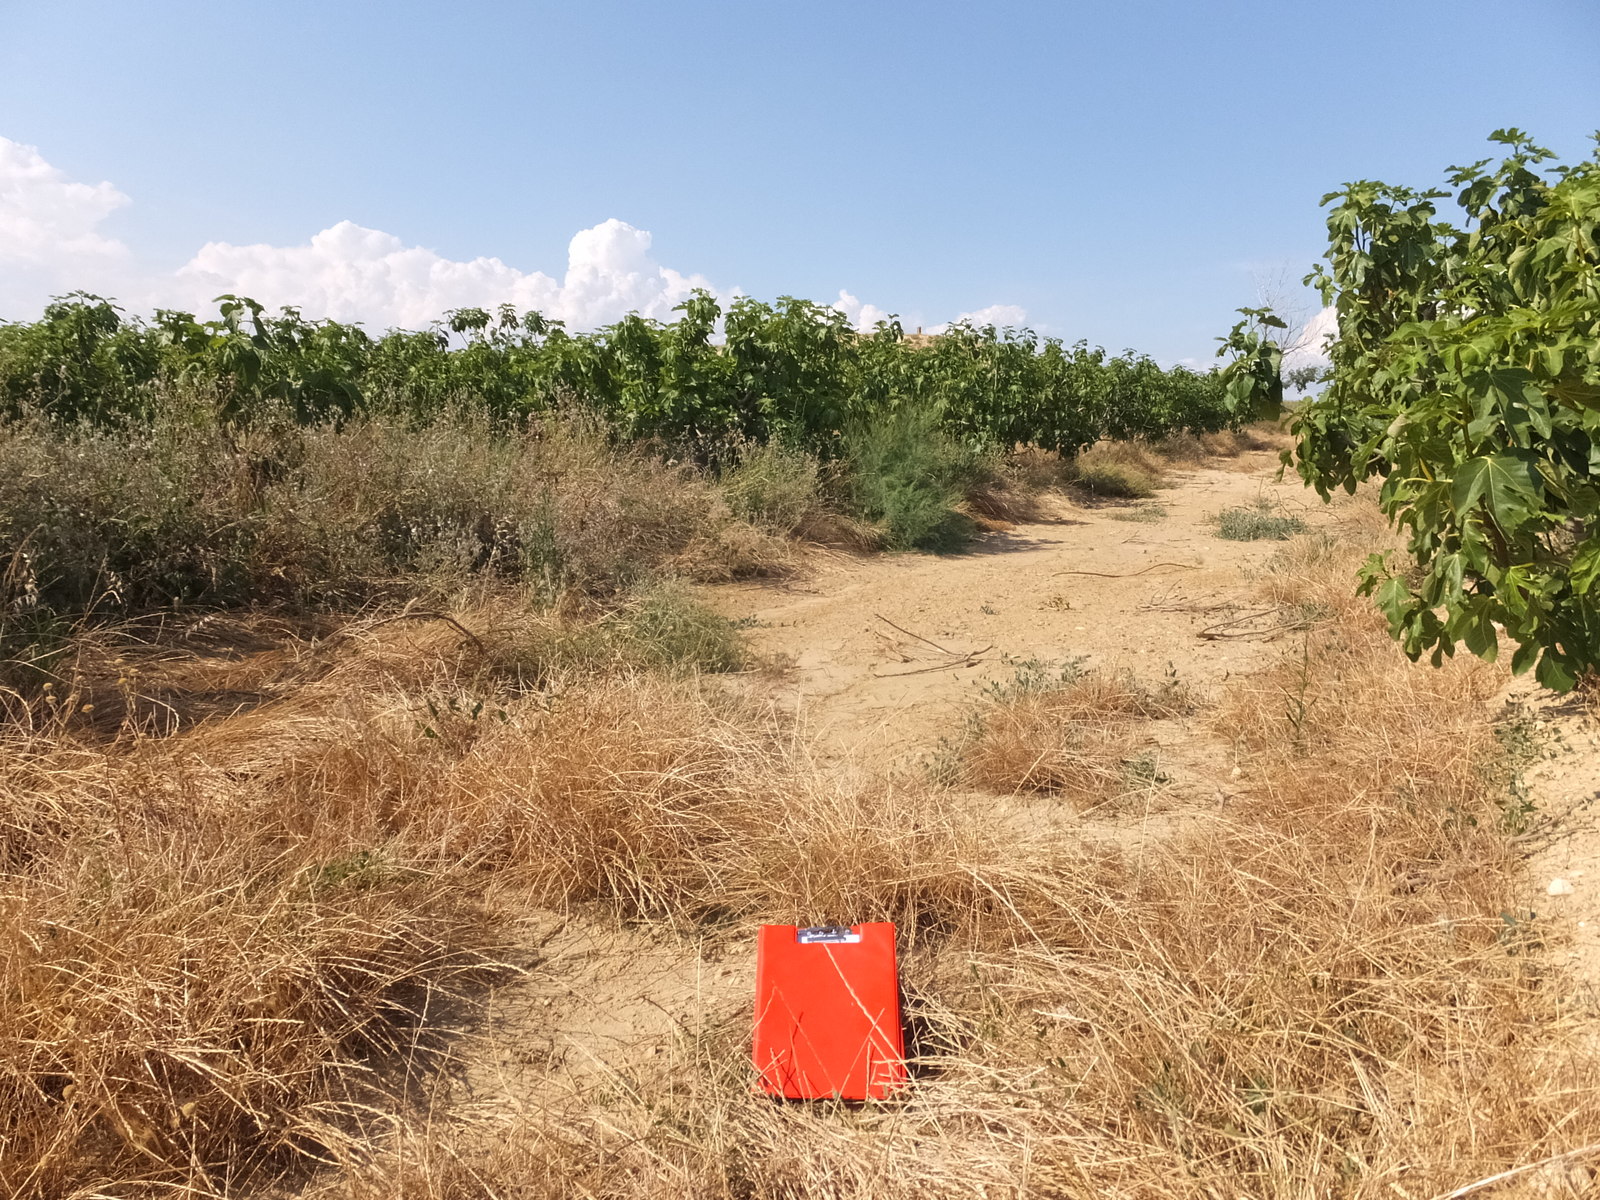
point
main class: Cropland
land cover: Other fruit trees and berries
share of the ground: > 75 %
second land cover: Spontaneously vegetated surfaces
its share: 10 - 25 %
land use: Agriculture (excluding fallow land and kitchen gardens)
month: June
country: ES
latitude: 41.7996
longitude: 0.0543
